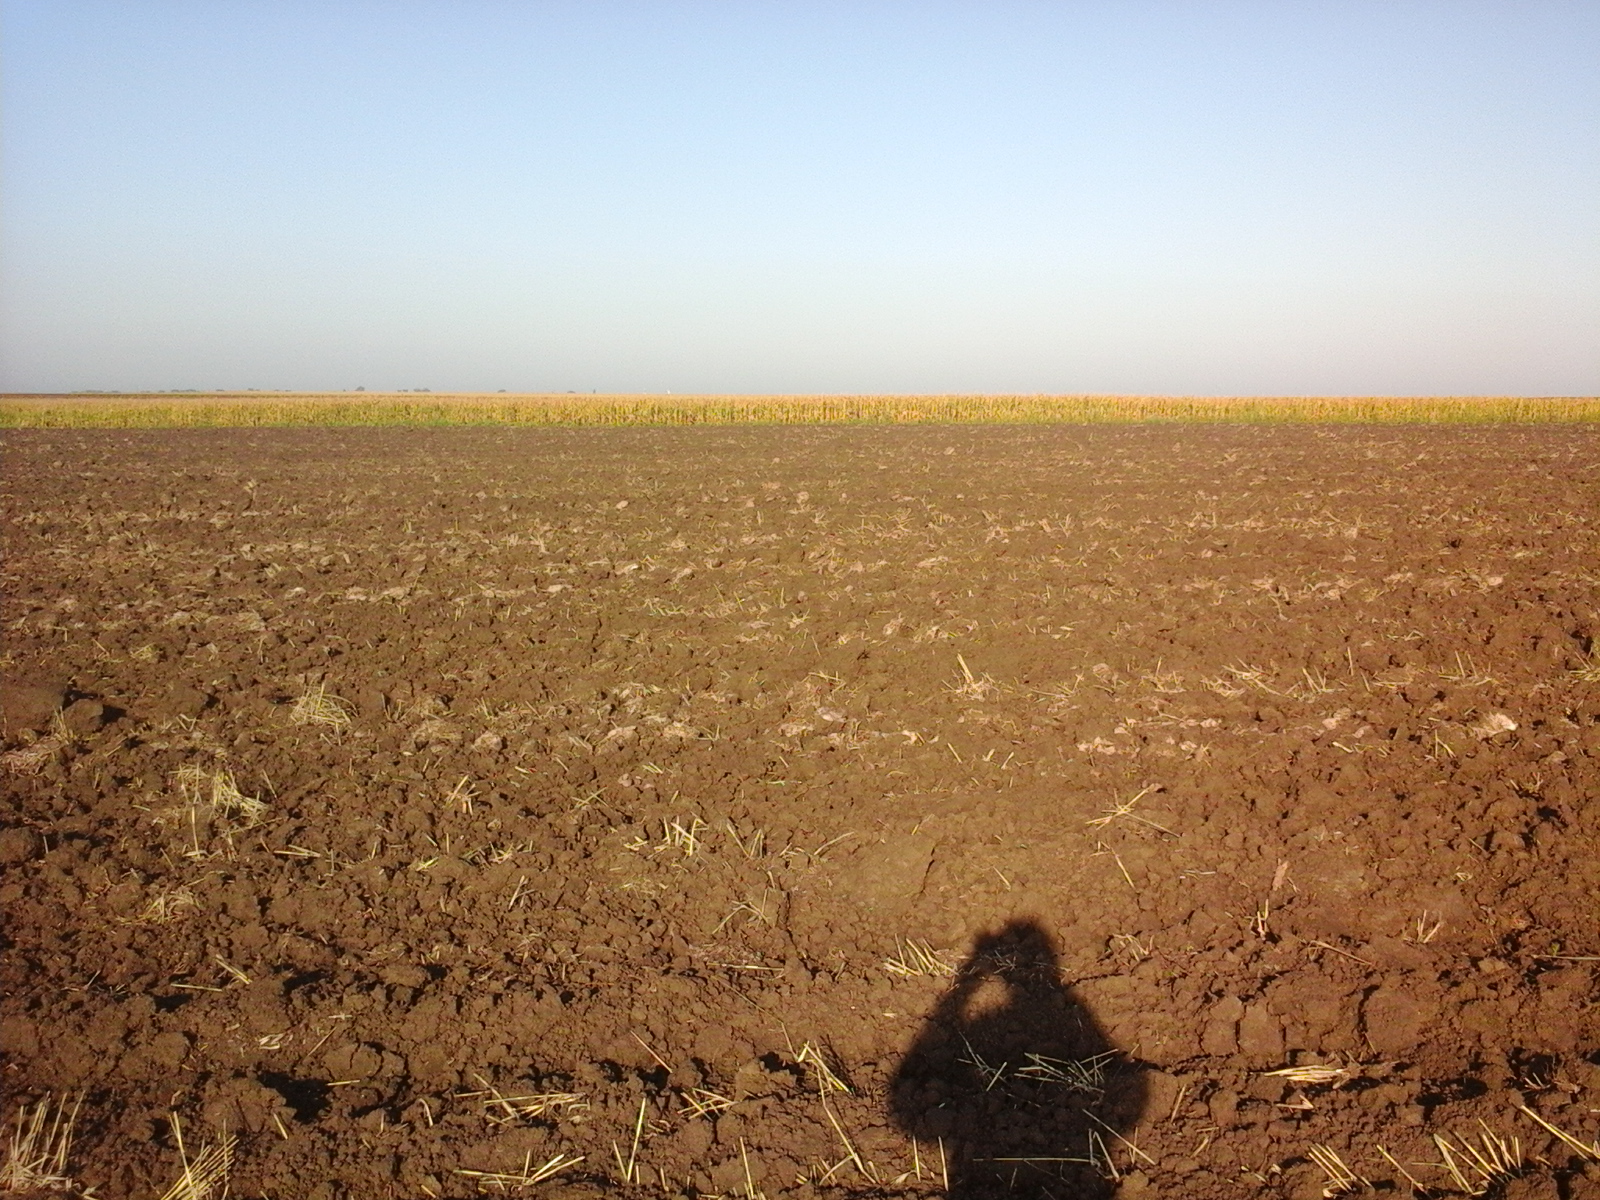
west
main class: Cropland
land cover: Common wheat
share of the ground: < 10 %
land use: Agriculture (excluding fallow land and kitchen gardens)
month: August
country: RO
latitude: 46.0161
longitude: 21.0213
